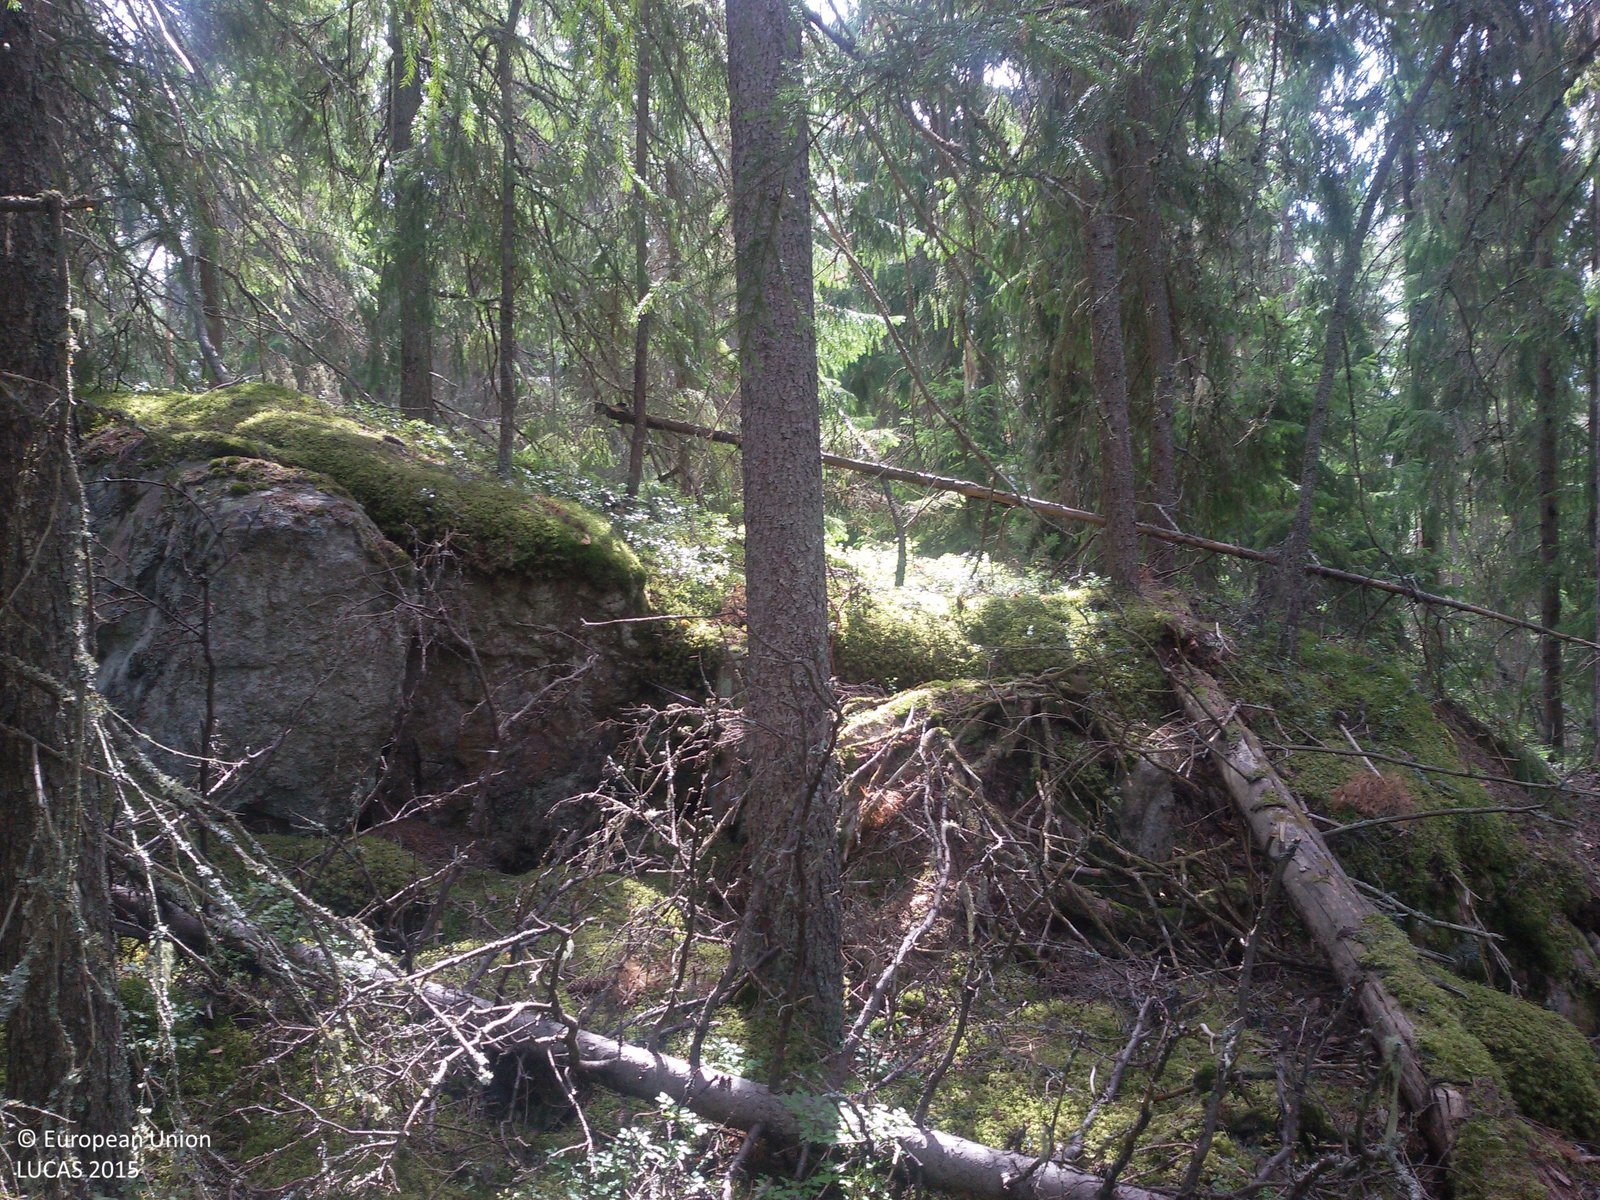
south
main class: Woodland
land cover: Spruce dominated coniferous woodland
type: boreal forest
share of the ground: > 75 %
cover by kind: coniferous forest trees 70 %, herbaceous plants 15 %, broadleaved forest trees 10 %, lichens and mosses 5 %
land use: Forestry
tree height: > 5 m
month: July
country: SE
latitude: 60.4485
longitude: 15.6045
